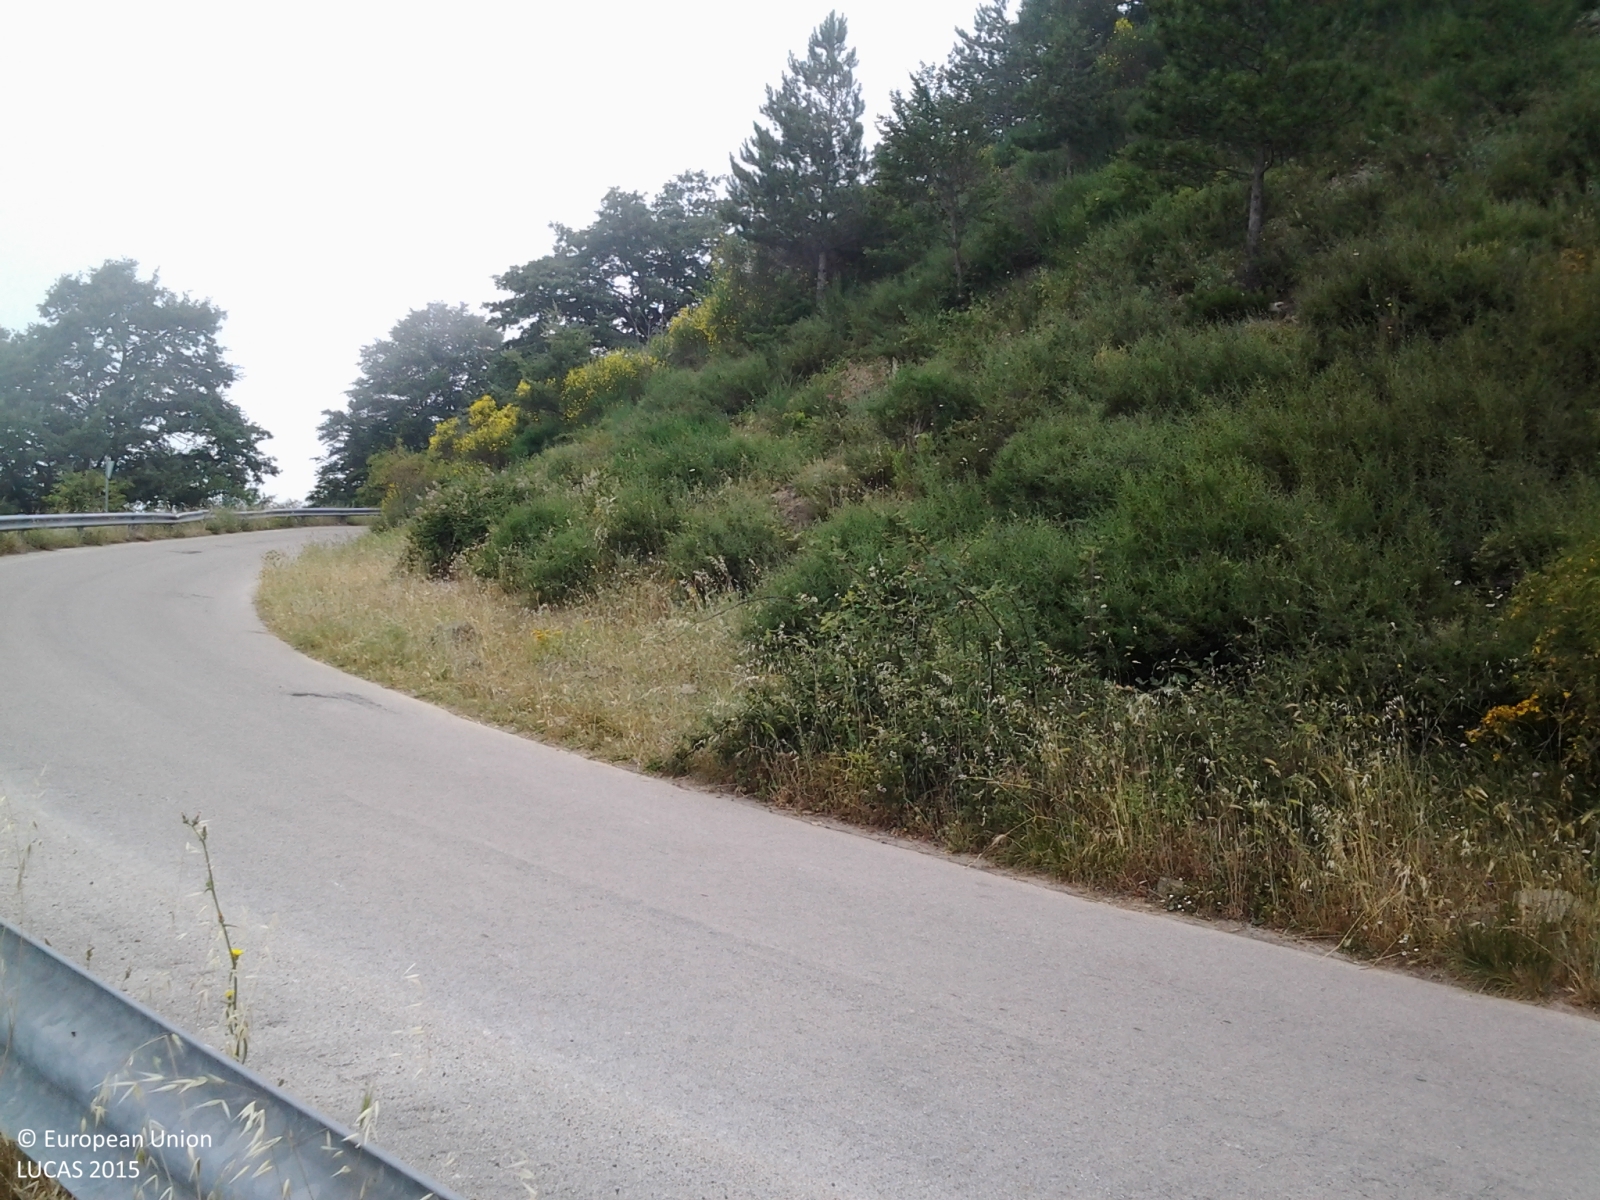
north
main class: Woodland
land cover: Broadleaved woodland
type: thermophilous deciduous forest
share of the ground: > 75 %
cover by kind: broadleaved forest trees 90 %, shrubs 5 %, herbaceous plants 5 %
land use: Amenities, museums, leisure
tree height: > 5 m
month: July
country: IT
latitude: 37.9861
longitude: 14.8745
